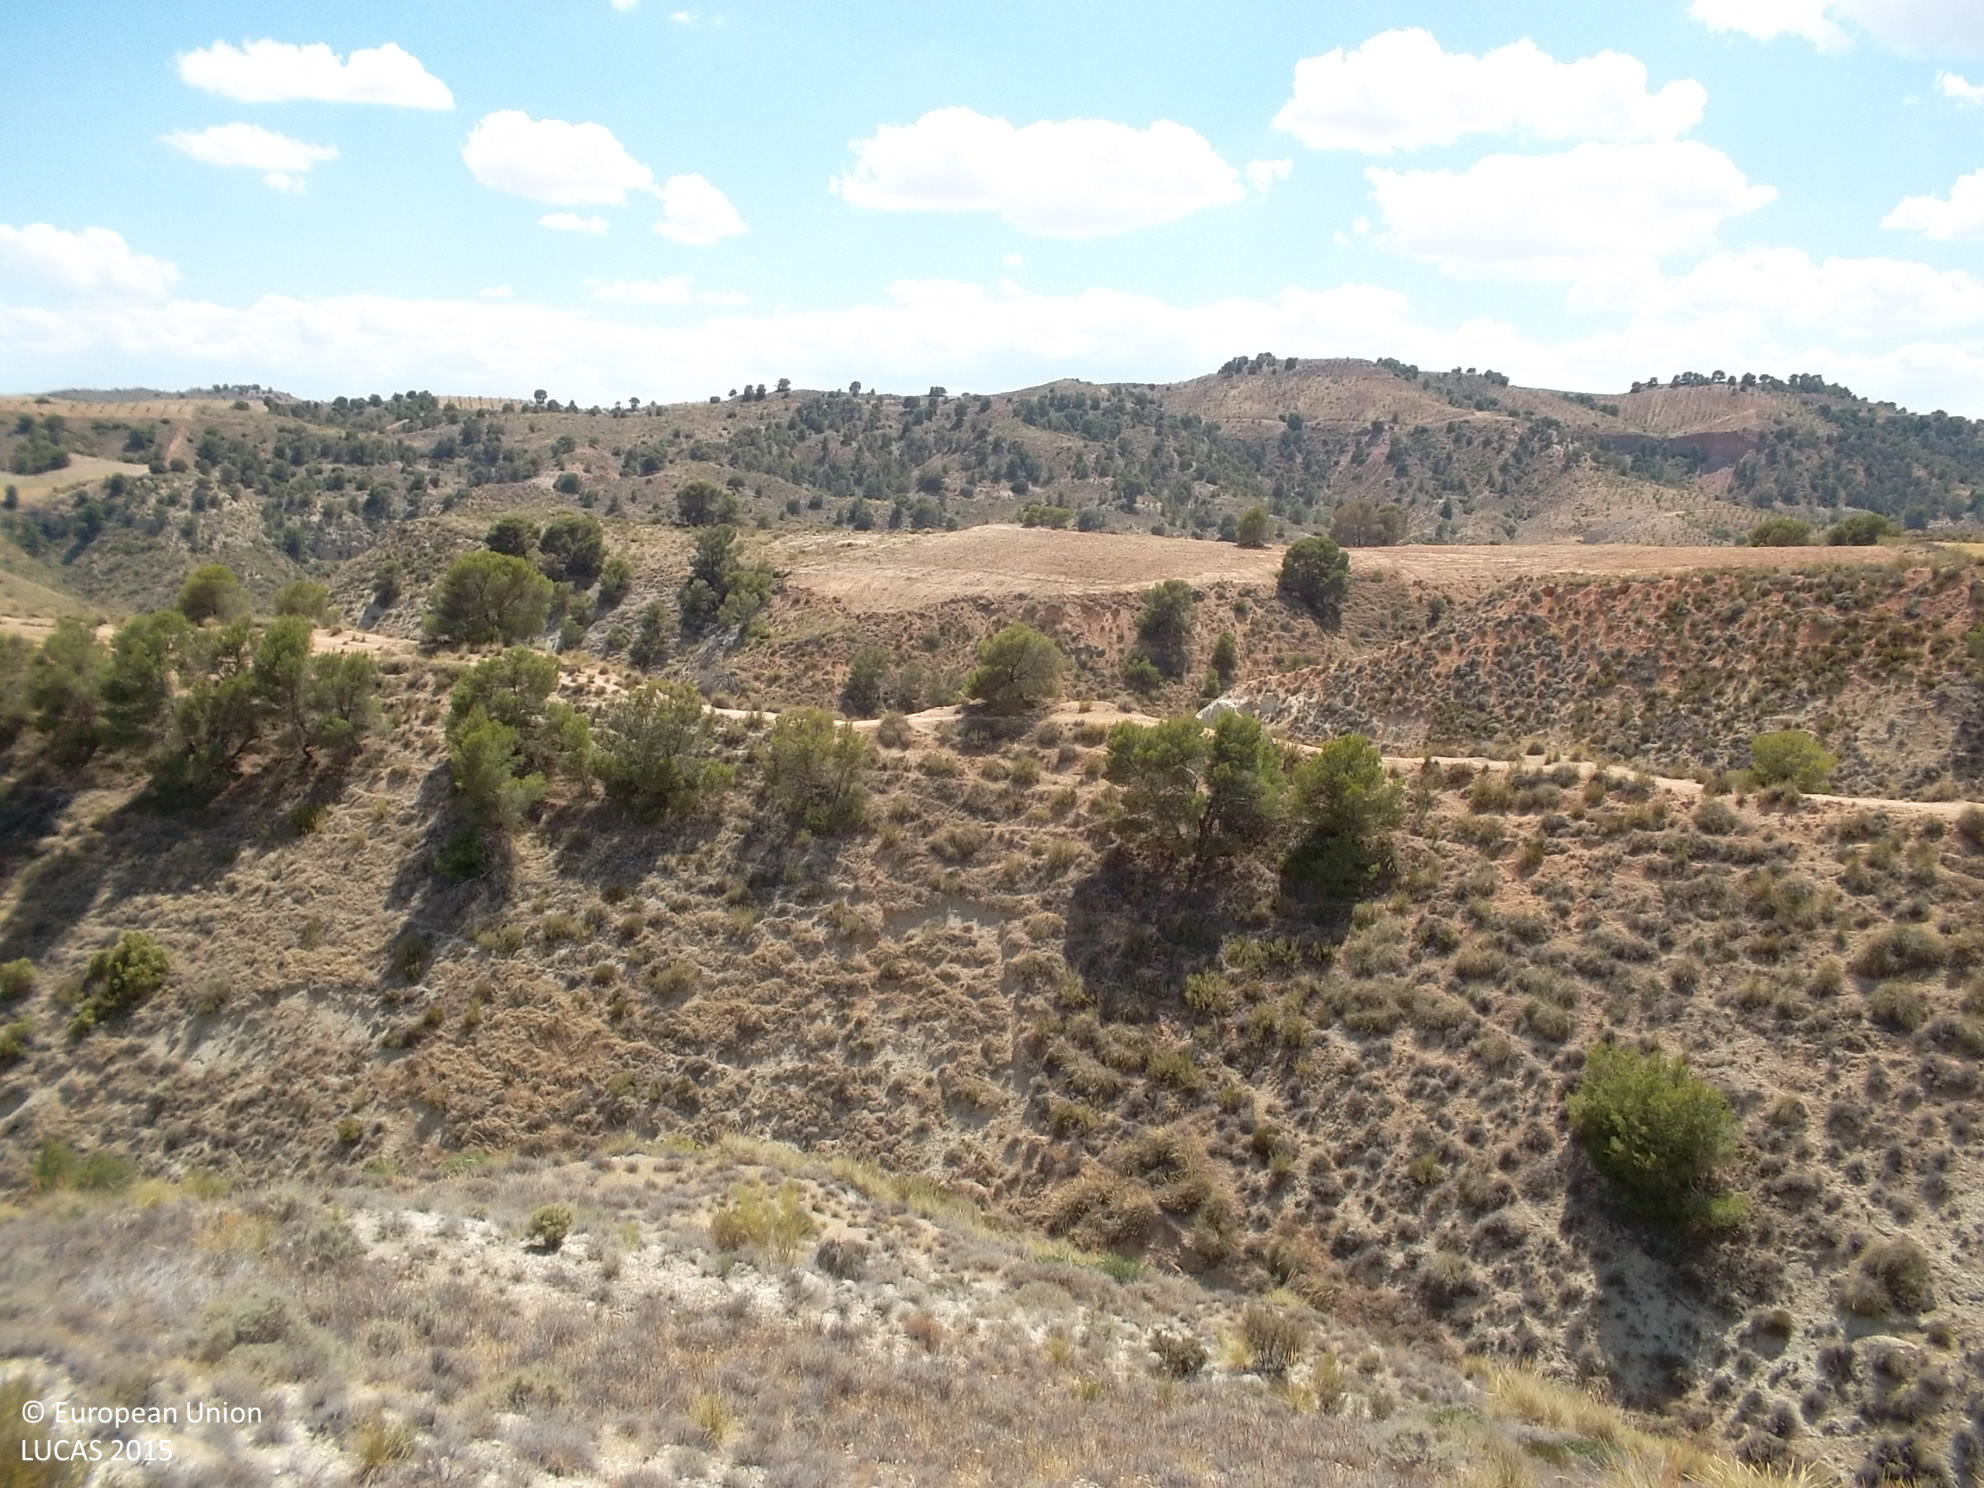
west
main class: Grassland
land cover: Grassland with sparse tree/shrub cover
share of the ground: > 75 %
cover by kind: herbaceous plants 85 %, shrubs 10 %, broadleaved forest trees 5 %
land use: Semi-natural and natural areas not in use
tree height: < 5 m
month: June
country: ES
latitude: 37.6490
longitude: -3.1972
